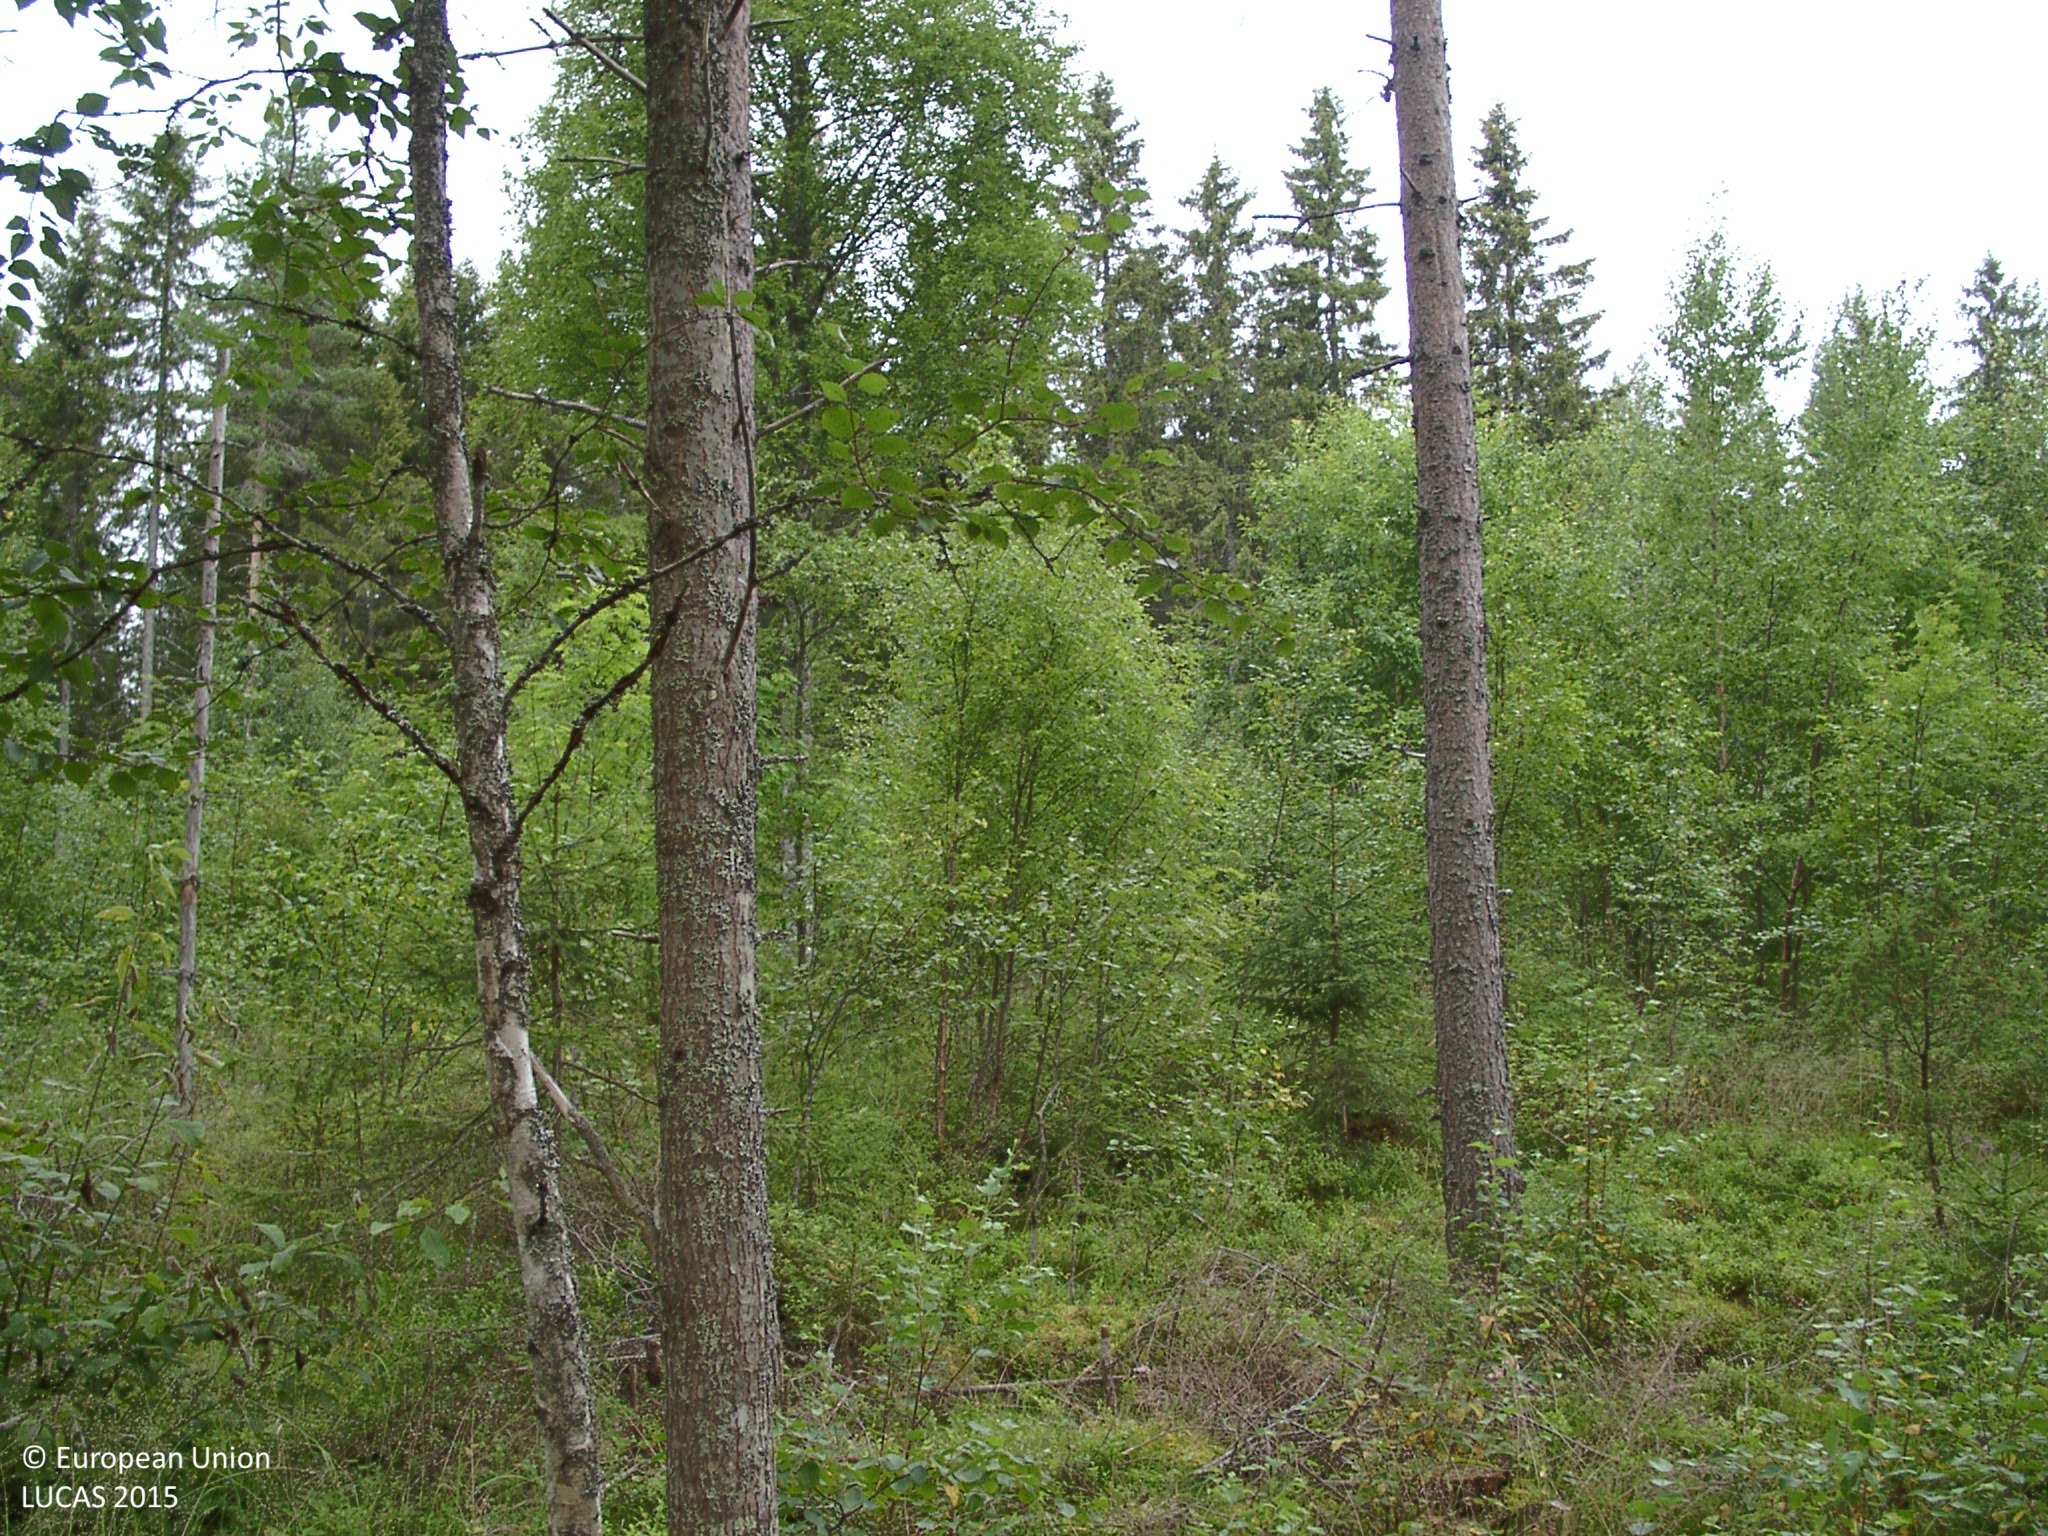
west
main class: Woodland
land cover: Pine dominated mixed woodland
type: boreal forest
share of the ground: 50 - 75 %
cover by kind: coniferous forest trees 45 %, broadleaved forest trees 20 %, shrubs 15 %, herbaceous plants 10 %, lichens and mosses 5 %
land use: Forestry
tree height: > 5 m
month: August
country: FI
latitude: 62.8553
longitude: 24.5672
